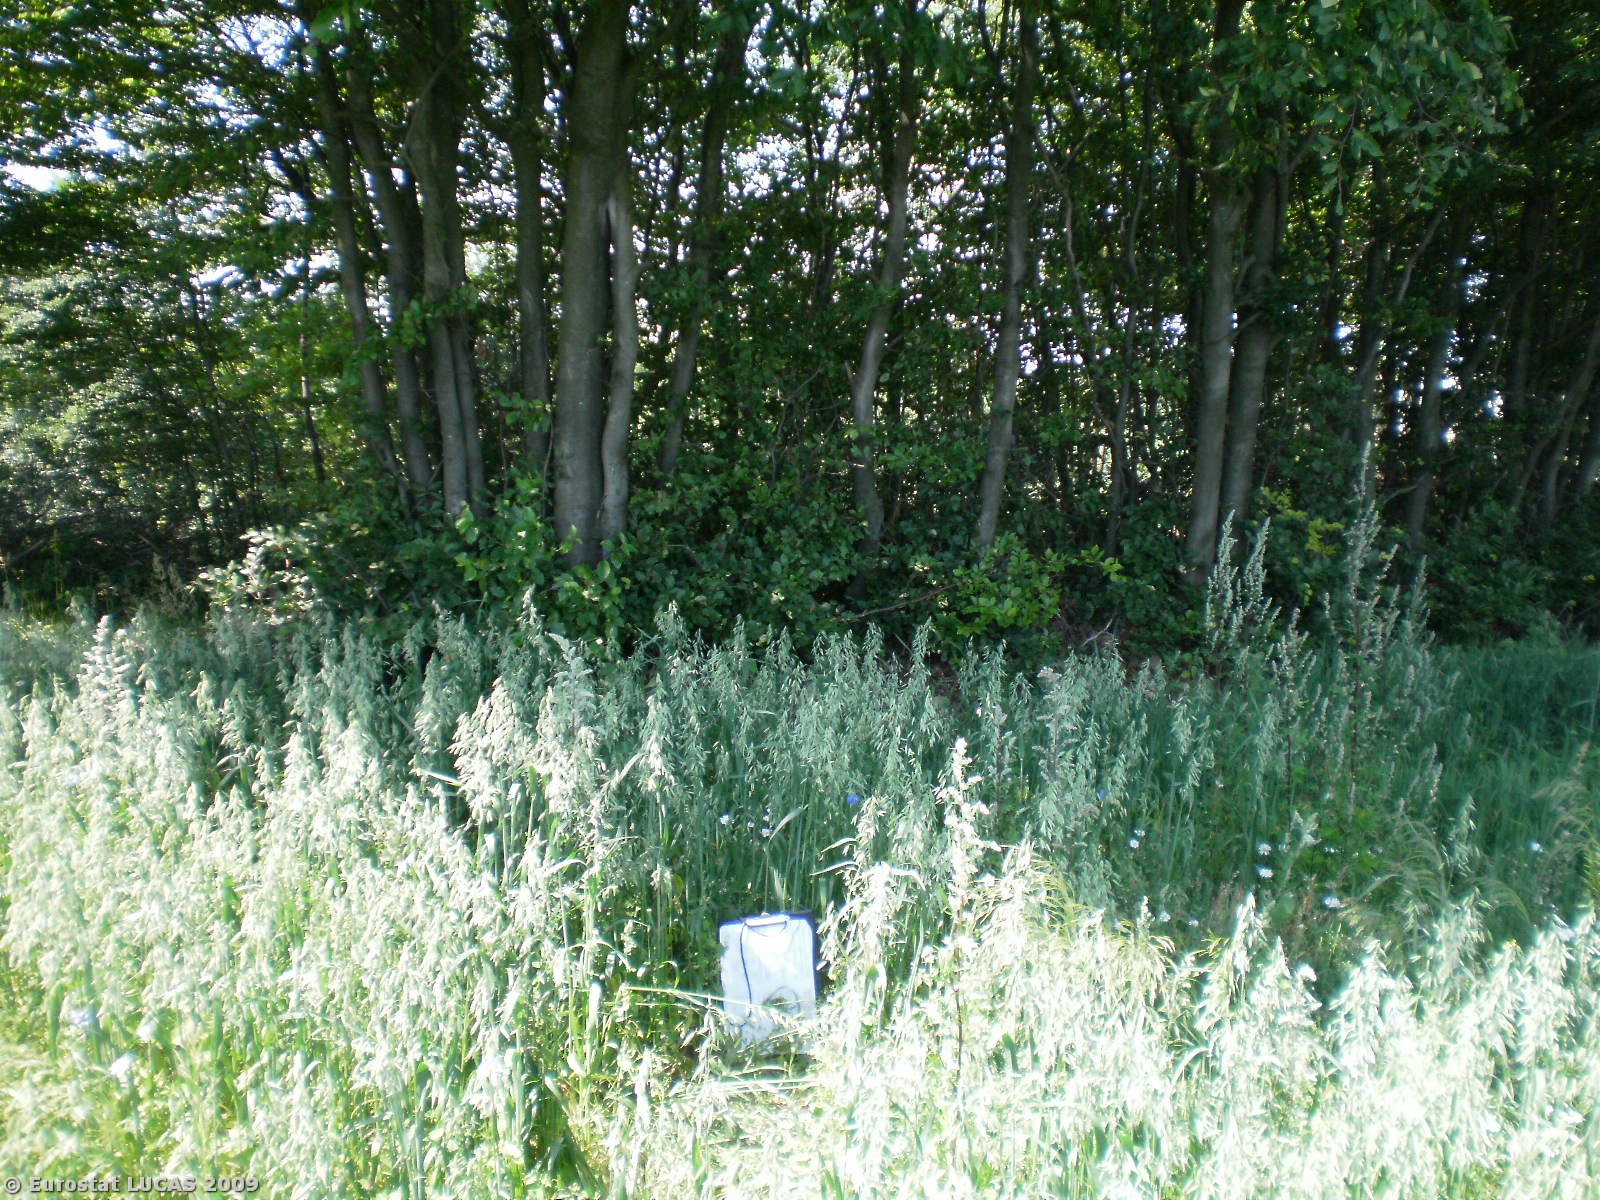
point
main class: Cropland
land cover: Oats
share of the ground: > 75 %
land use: Agriculture (excluding fallow land and kitchen gardens)
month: July
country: PL
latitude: 54.2803
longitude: 17.9232
